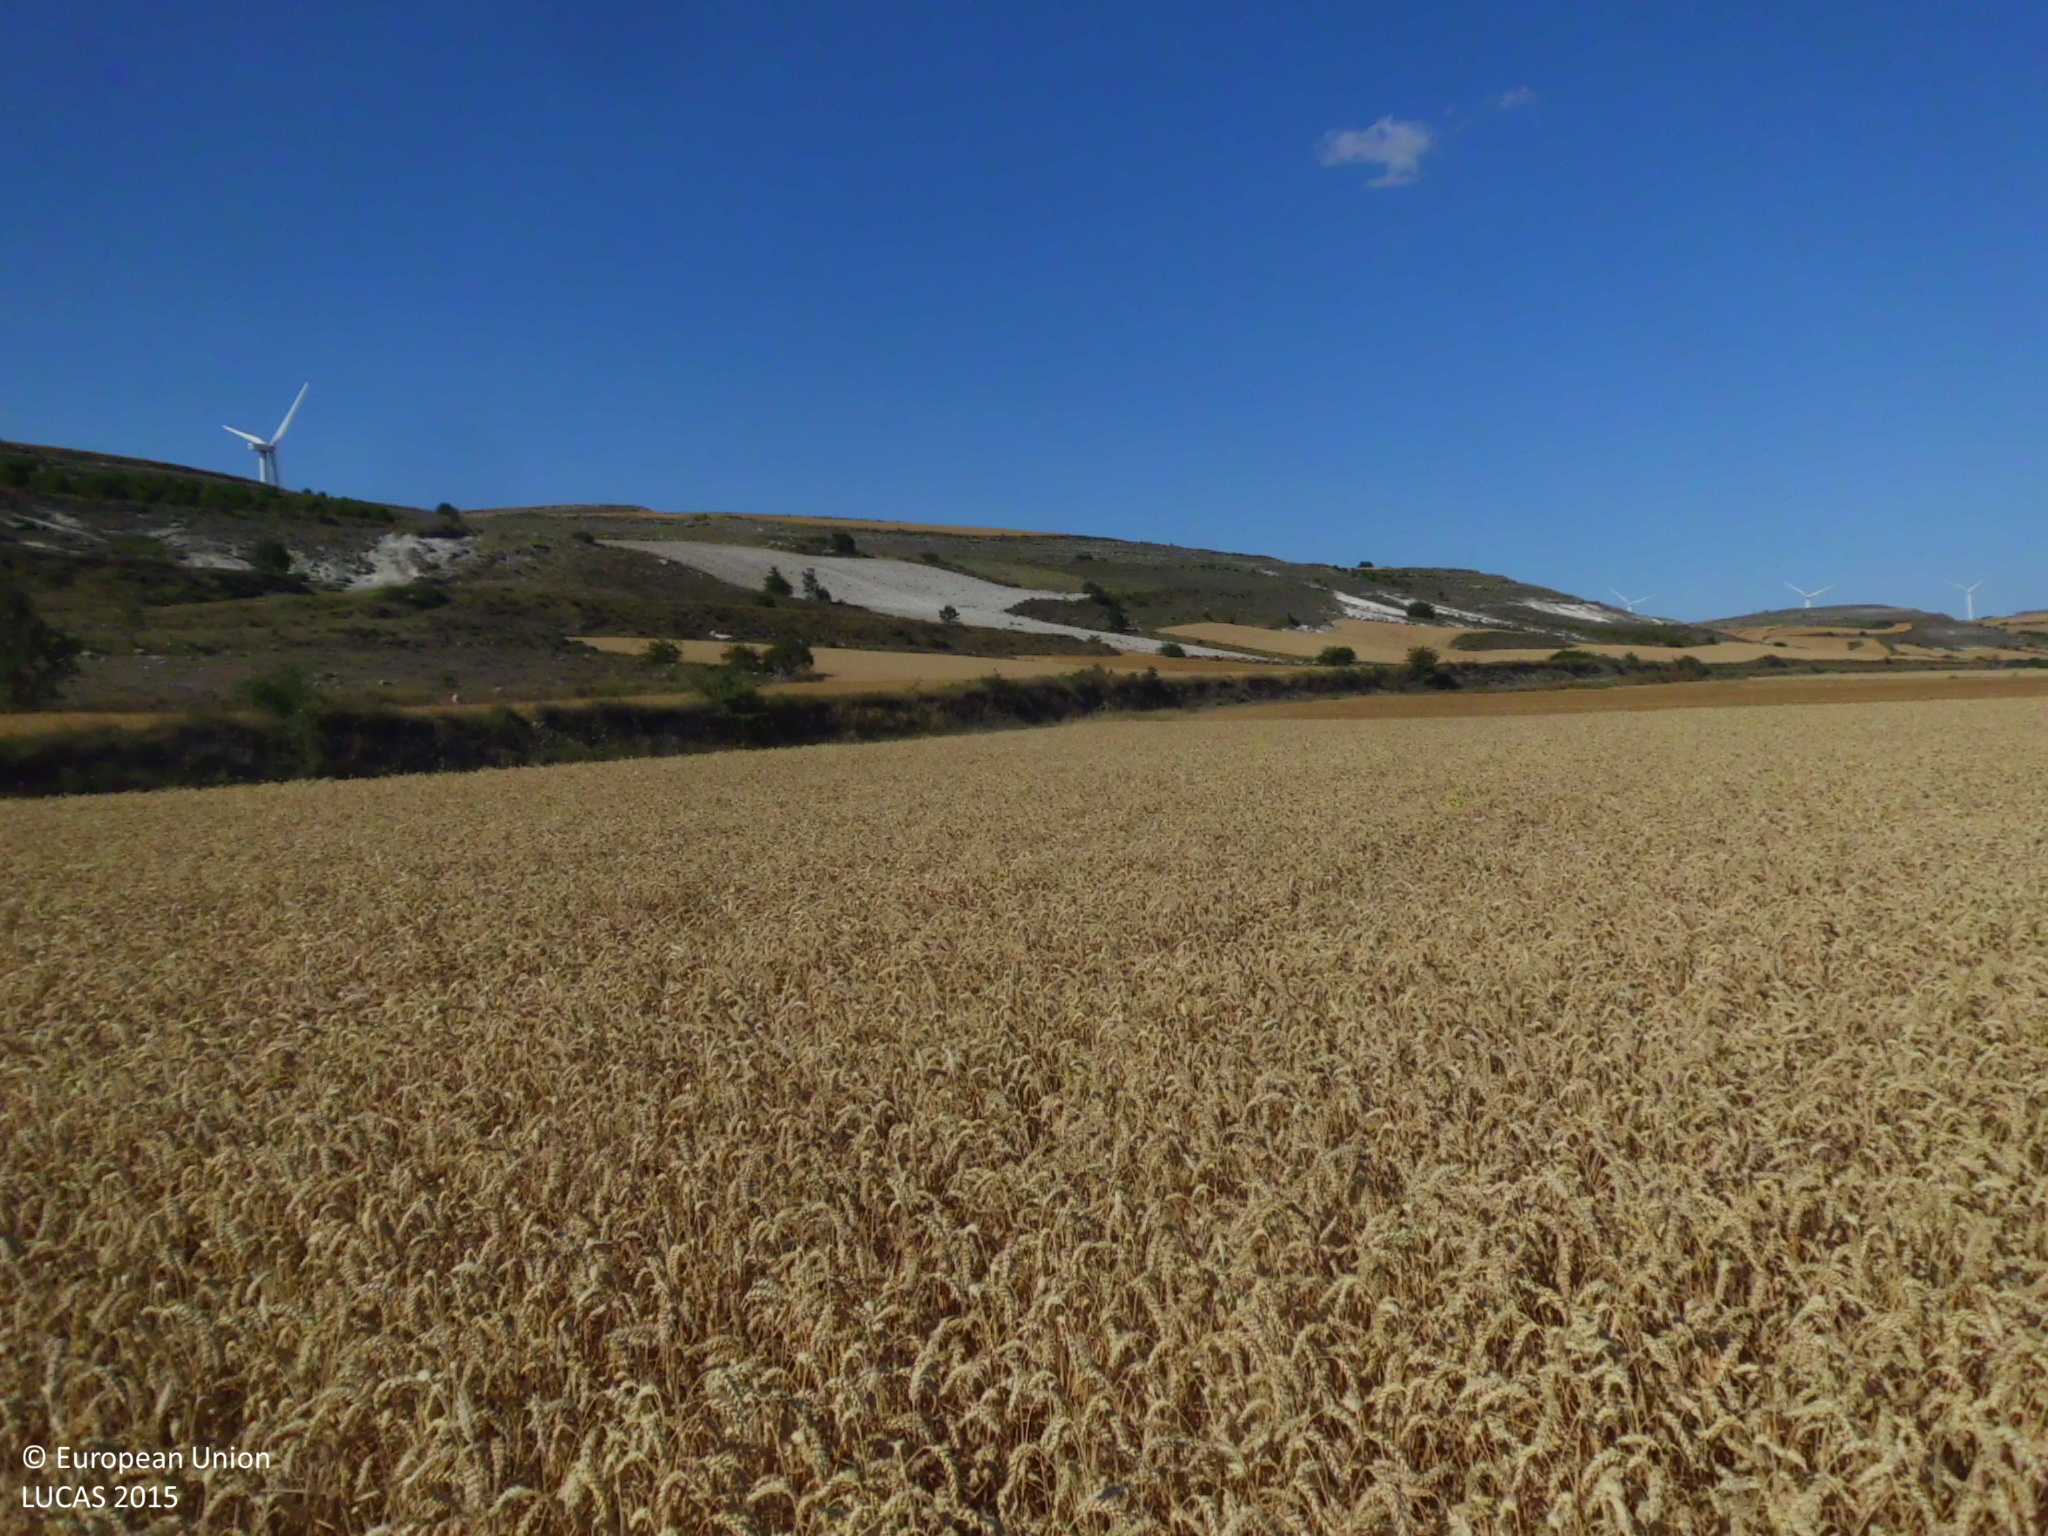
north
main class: Cropland
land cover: Common wheat
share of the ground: > 75 %
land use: Agriculture (excluding fallow land and kitchen gardens)
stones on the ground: 10 - 25 %
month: July
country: ES
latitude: 42.4245
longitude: -3.8833
